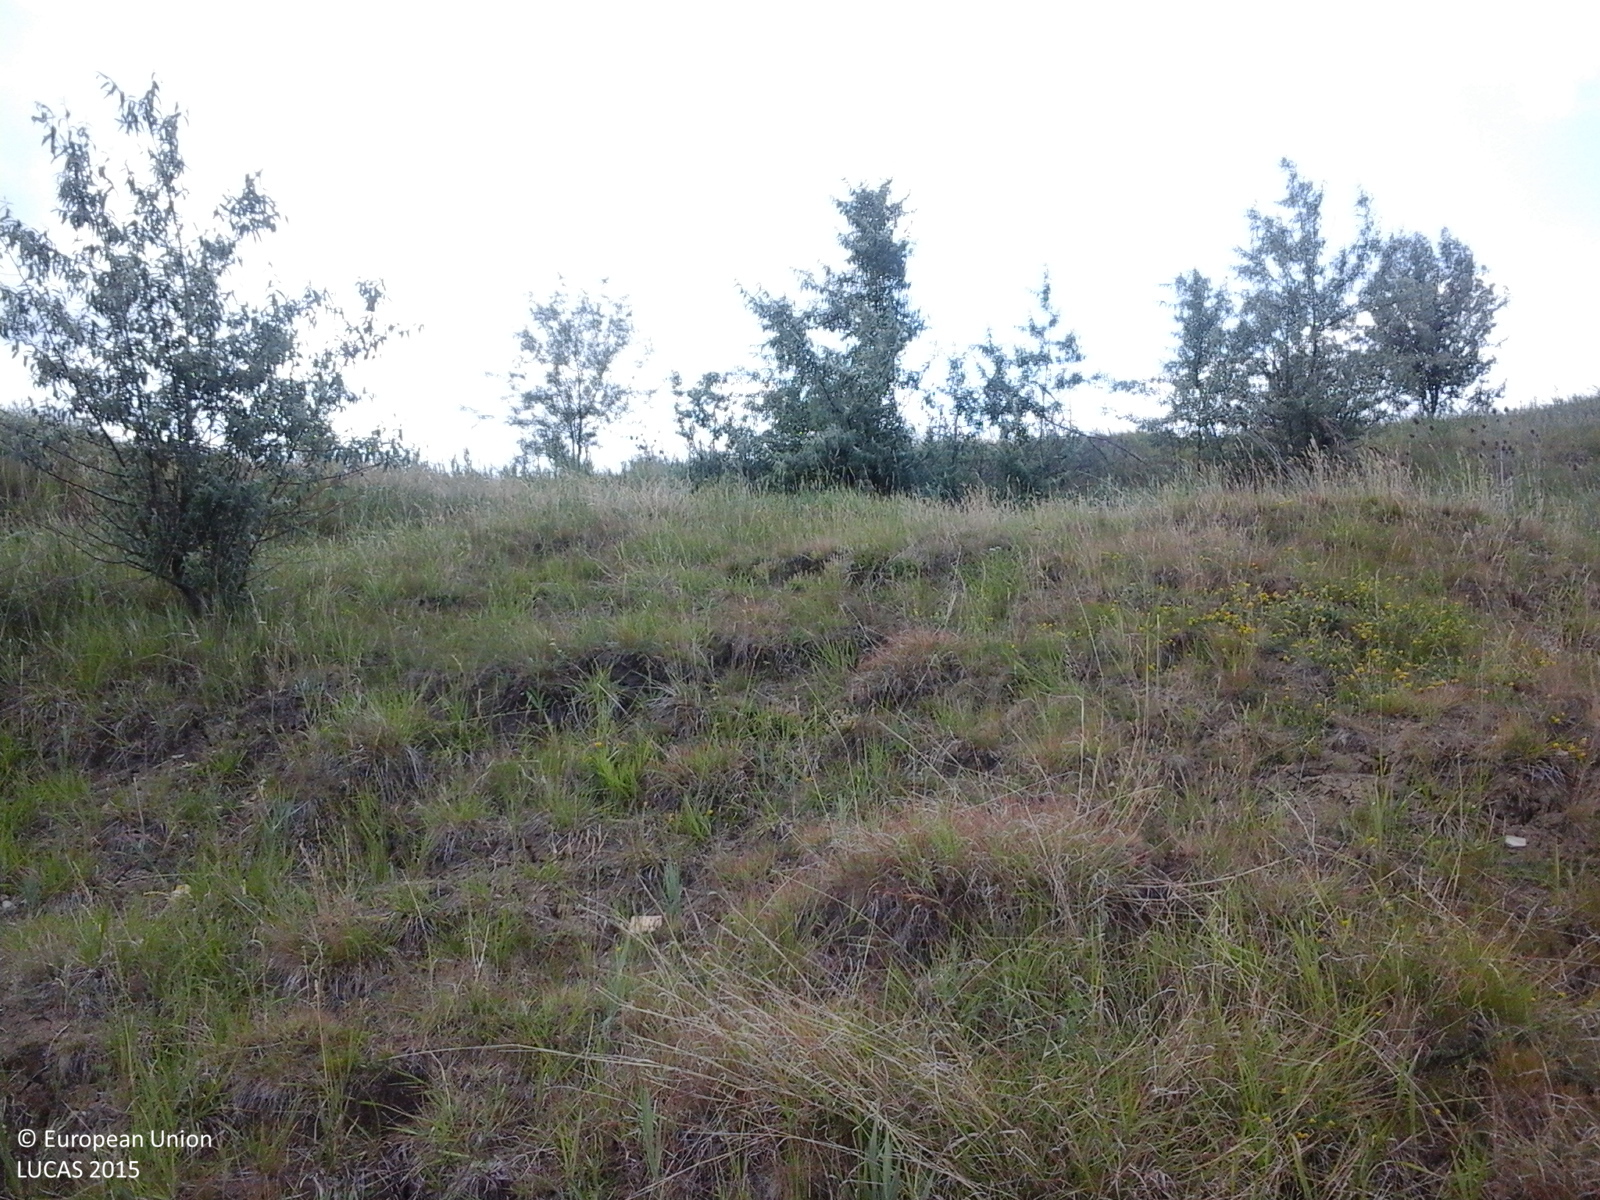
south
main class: Grassland
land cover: Grassland with sparse tree/shrub cover
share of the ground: > 75 %
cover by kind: herbaceous plants 90 %, broadleaved forest trees 5 %, shrubs 5 %
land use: Agriculture (excluding fallow land and kitchen gardens)
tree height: < 5 m
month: June
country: RO
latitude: 47.6712
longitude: 27.0605
